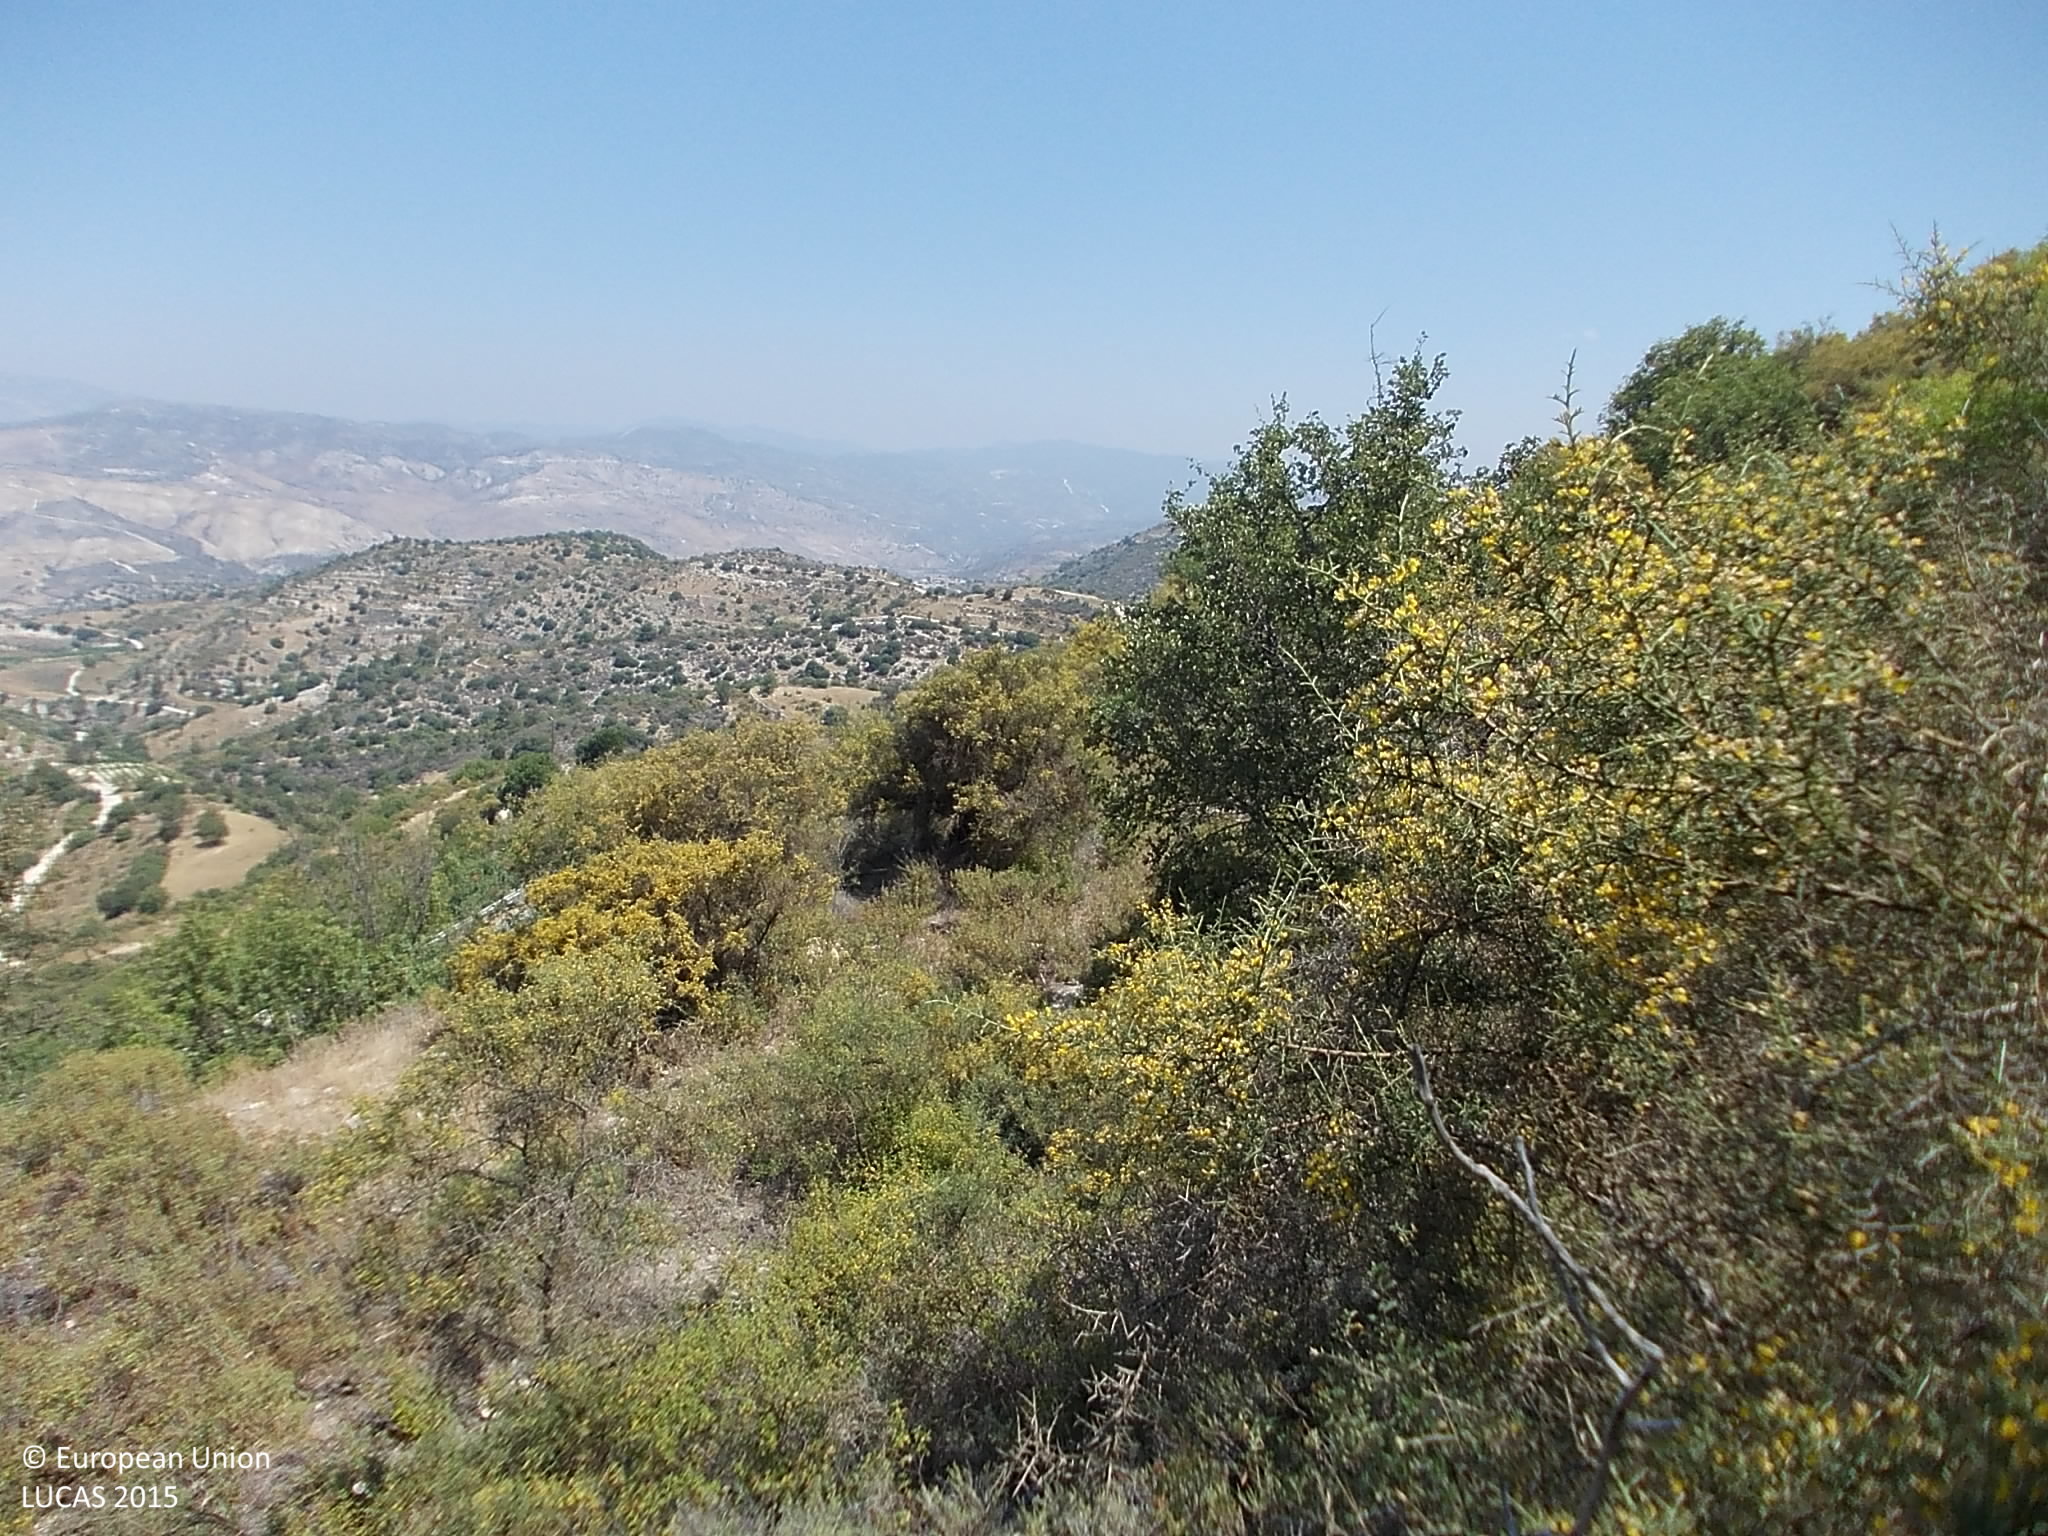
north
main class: Woodland
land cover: Broadleaved woodland
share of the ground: 10 - 25 %
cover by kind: shrubs 60 %, broadleaved forest trees 20 %, herbaceous plants 10 %, coniferous forest trees 5 %, unconsolidated bare surface 5 %
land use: Semi-natural and natural areas not in use
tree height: < 5 m
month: July
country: CY
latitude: 34.7717
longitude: 32.7187
